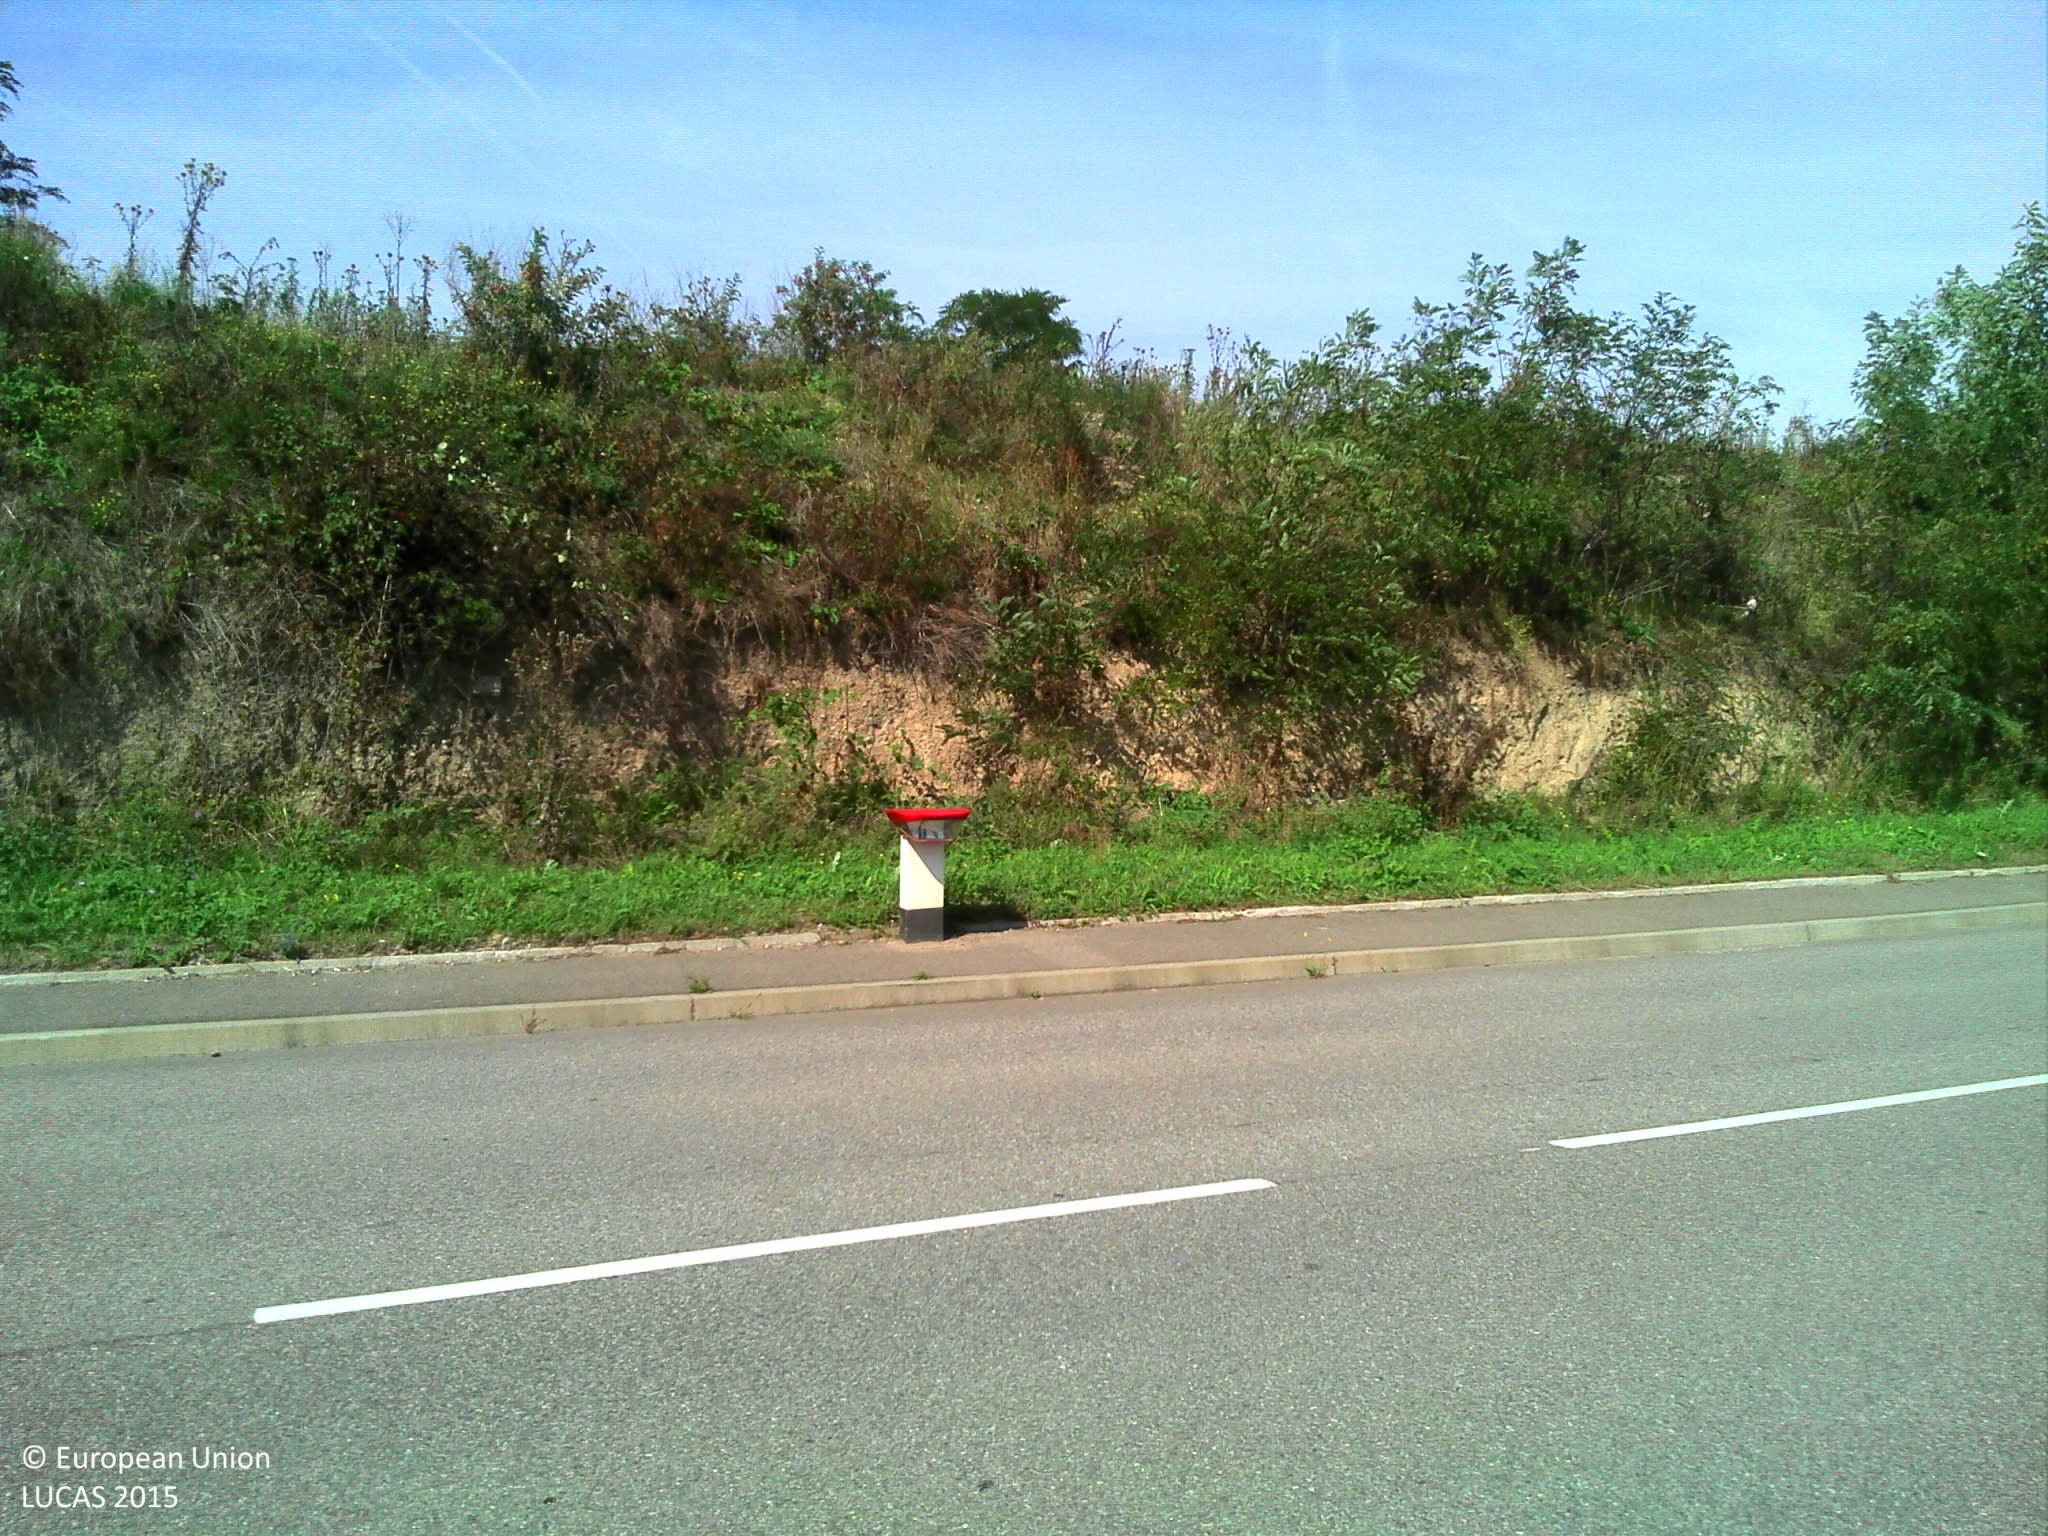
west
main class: Grassland
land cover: Grassland without tree/shrub cover
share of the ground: > 75 %
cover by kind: herbaceous plants 100 %
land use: Air transport
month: August
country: FR
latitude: 48.1018
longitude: 7.3556
